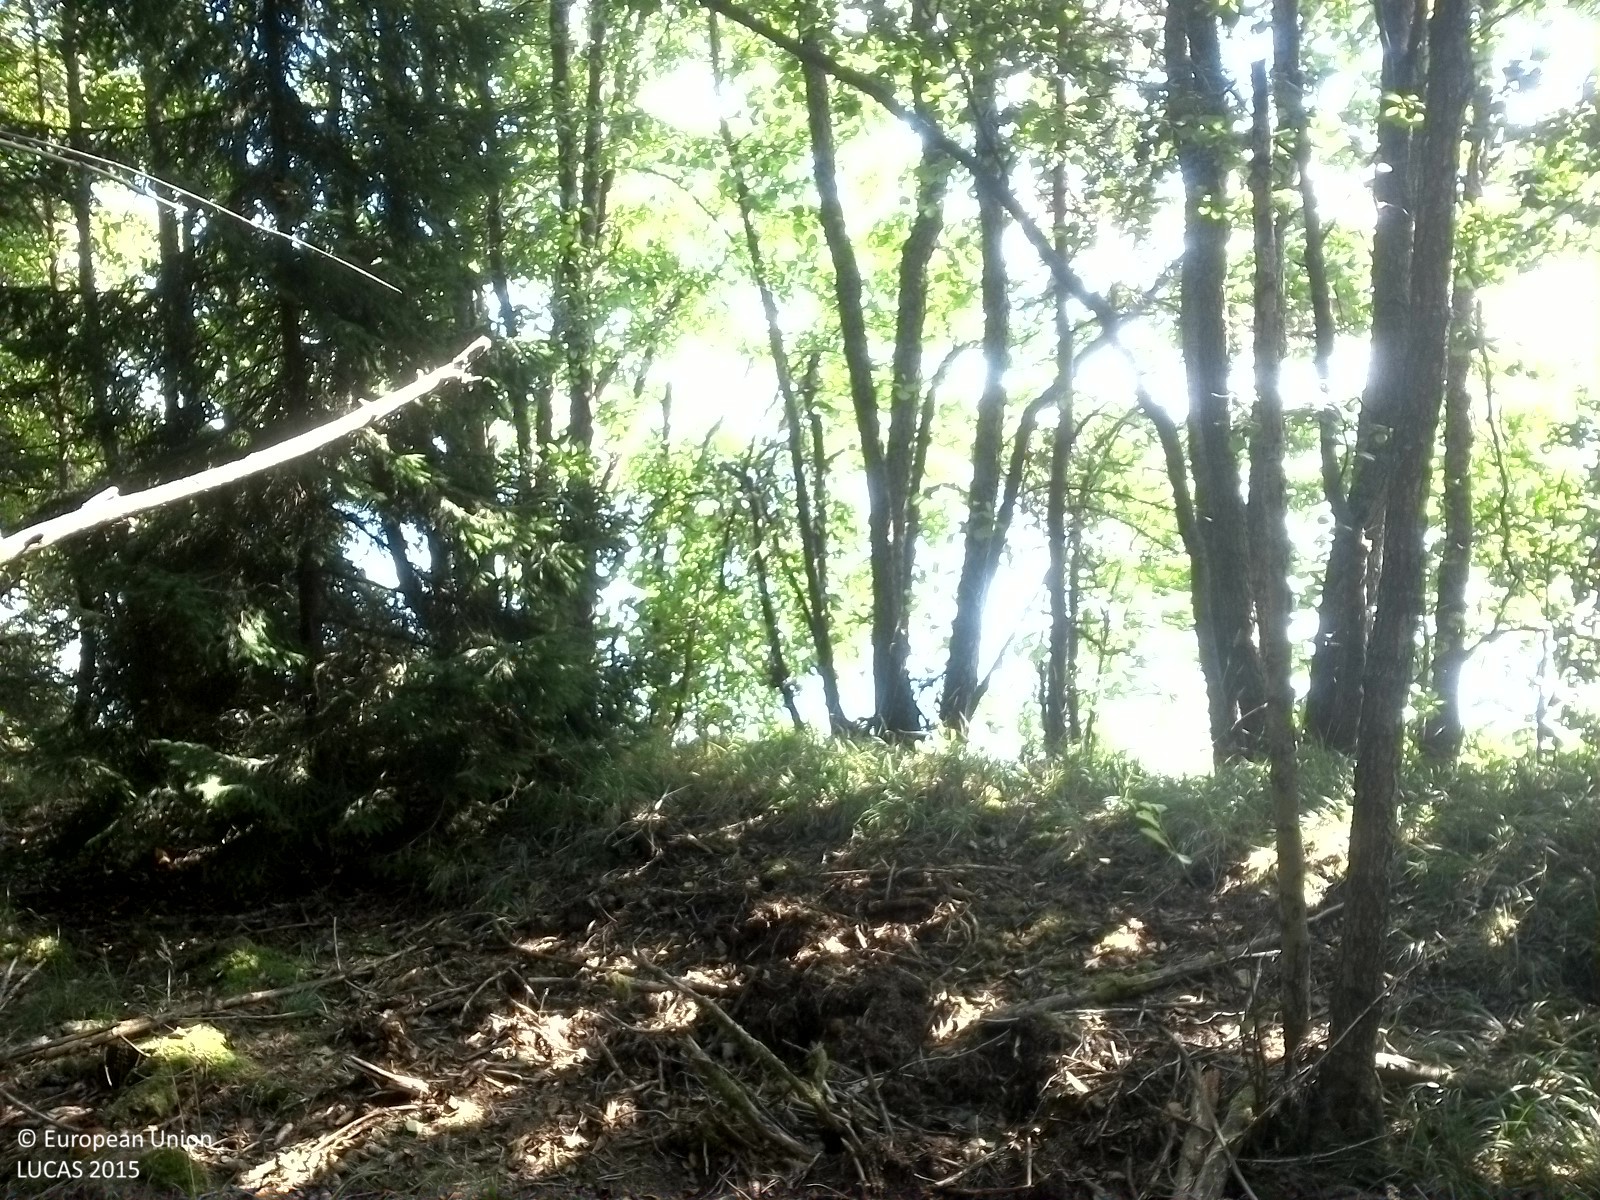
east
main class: Woodland
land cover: Spruce dominated coniferous woodland
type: boreal forest
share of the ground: 50 - 75 %
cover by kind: coniferous forest trees 70 %, herbaceous plants 10 %, lichens and mosses 10 %, unconsolidated bare surface 10 %
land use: Forestry
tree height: > 5 m
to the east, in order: Spruce dominated coniferous woodland; Broadleaved woodland; Inland fresh water bodies
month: August
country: SE
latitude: 58.9489
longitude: 15.6420
